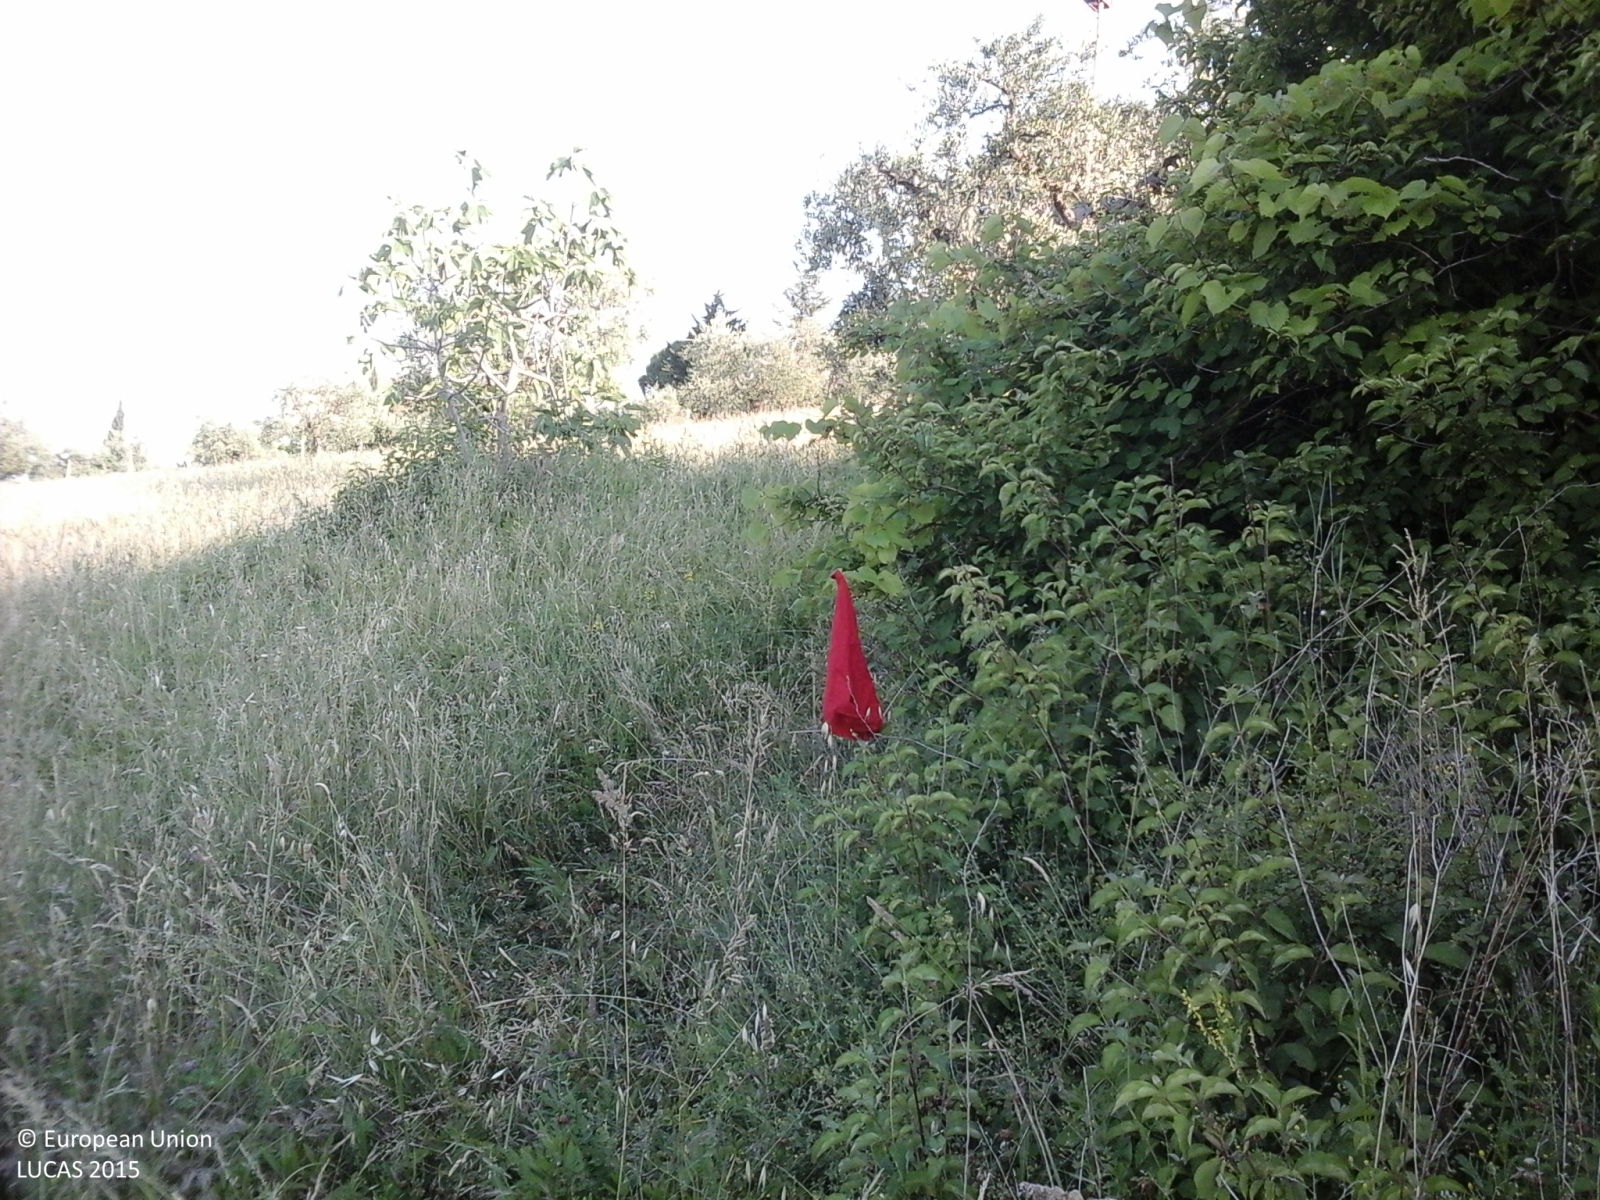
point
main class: Shrubland
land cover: Shrubland without tree cover
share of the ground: > 75 %
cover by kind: shrubs 100 %
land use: Semi-natural and natural areas not in use
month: June
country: IT
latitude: 42.8910
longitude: 13.7733
